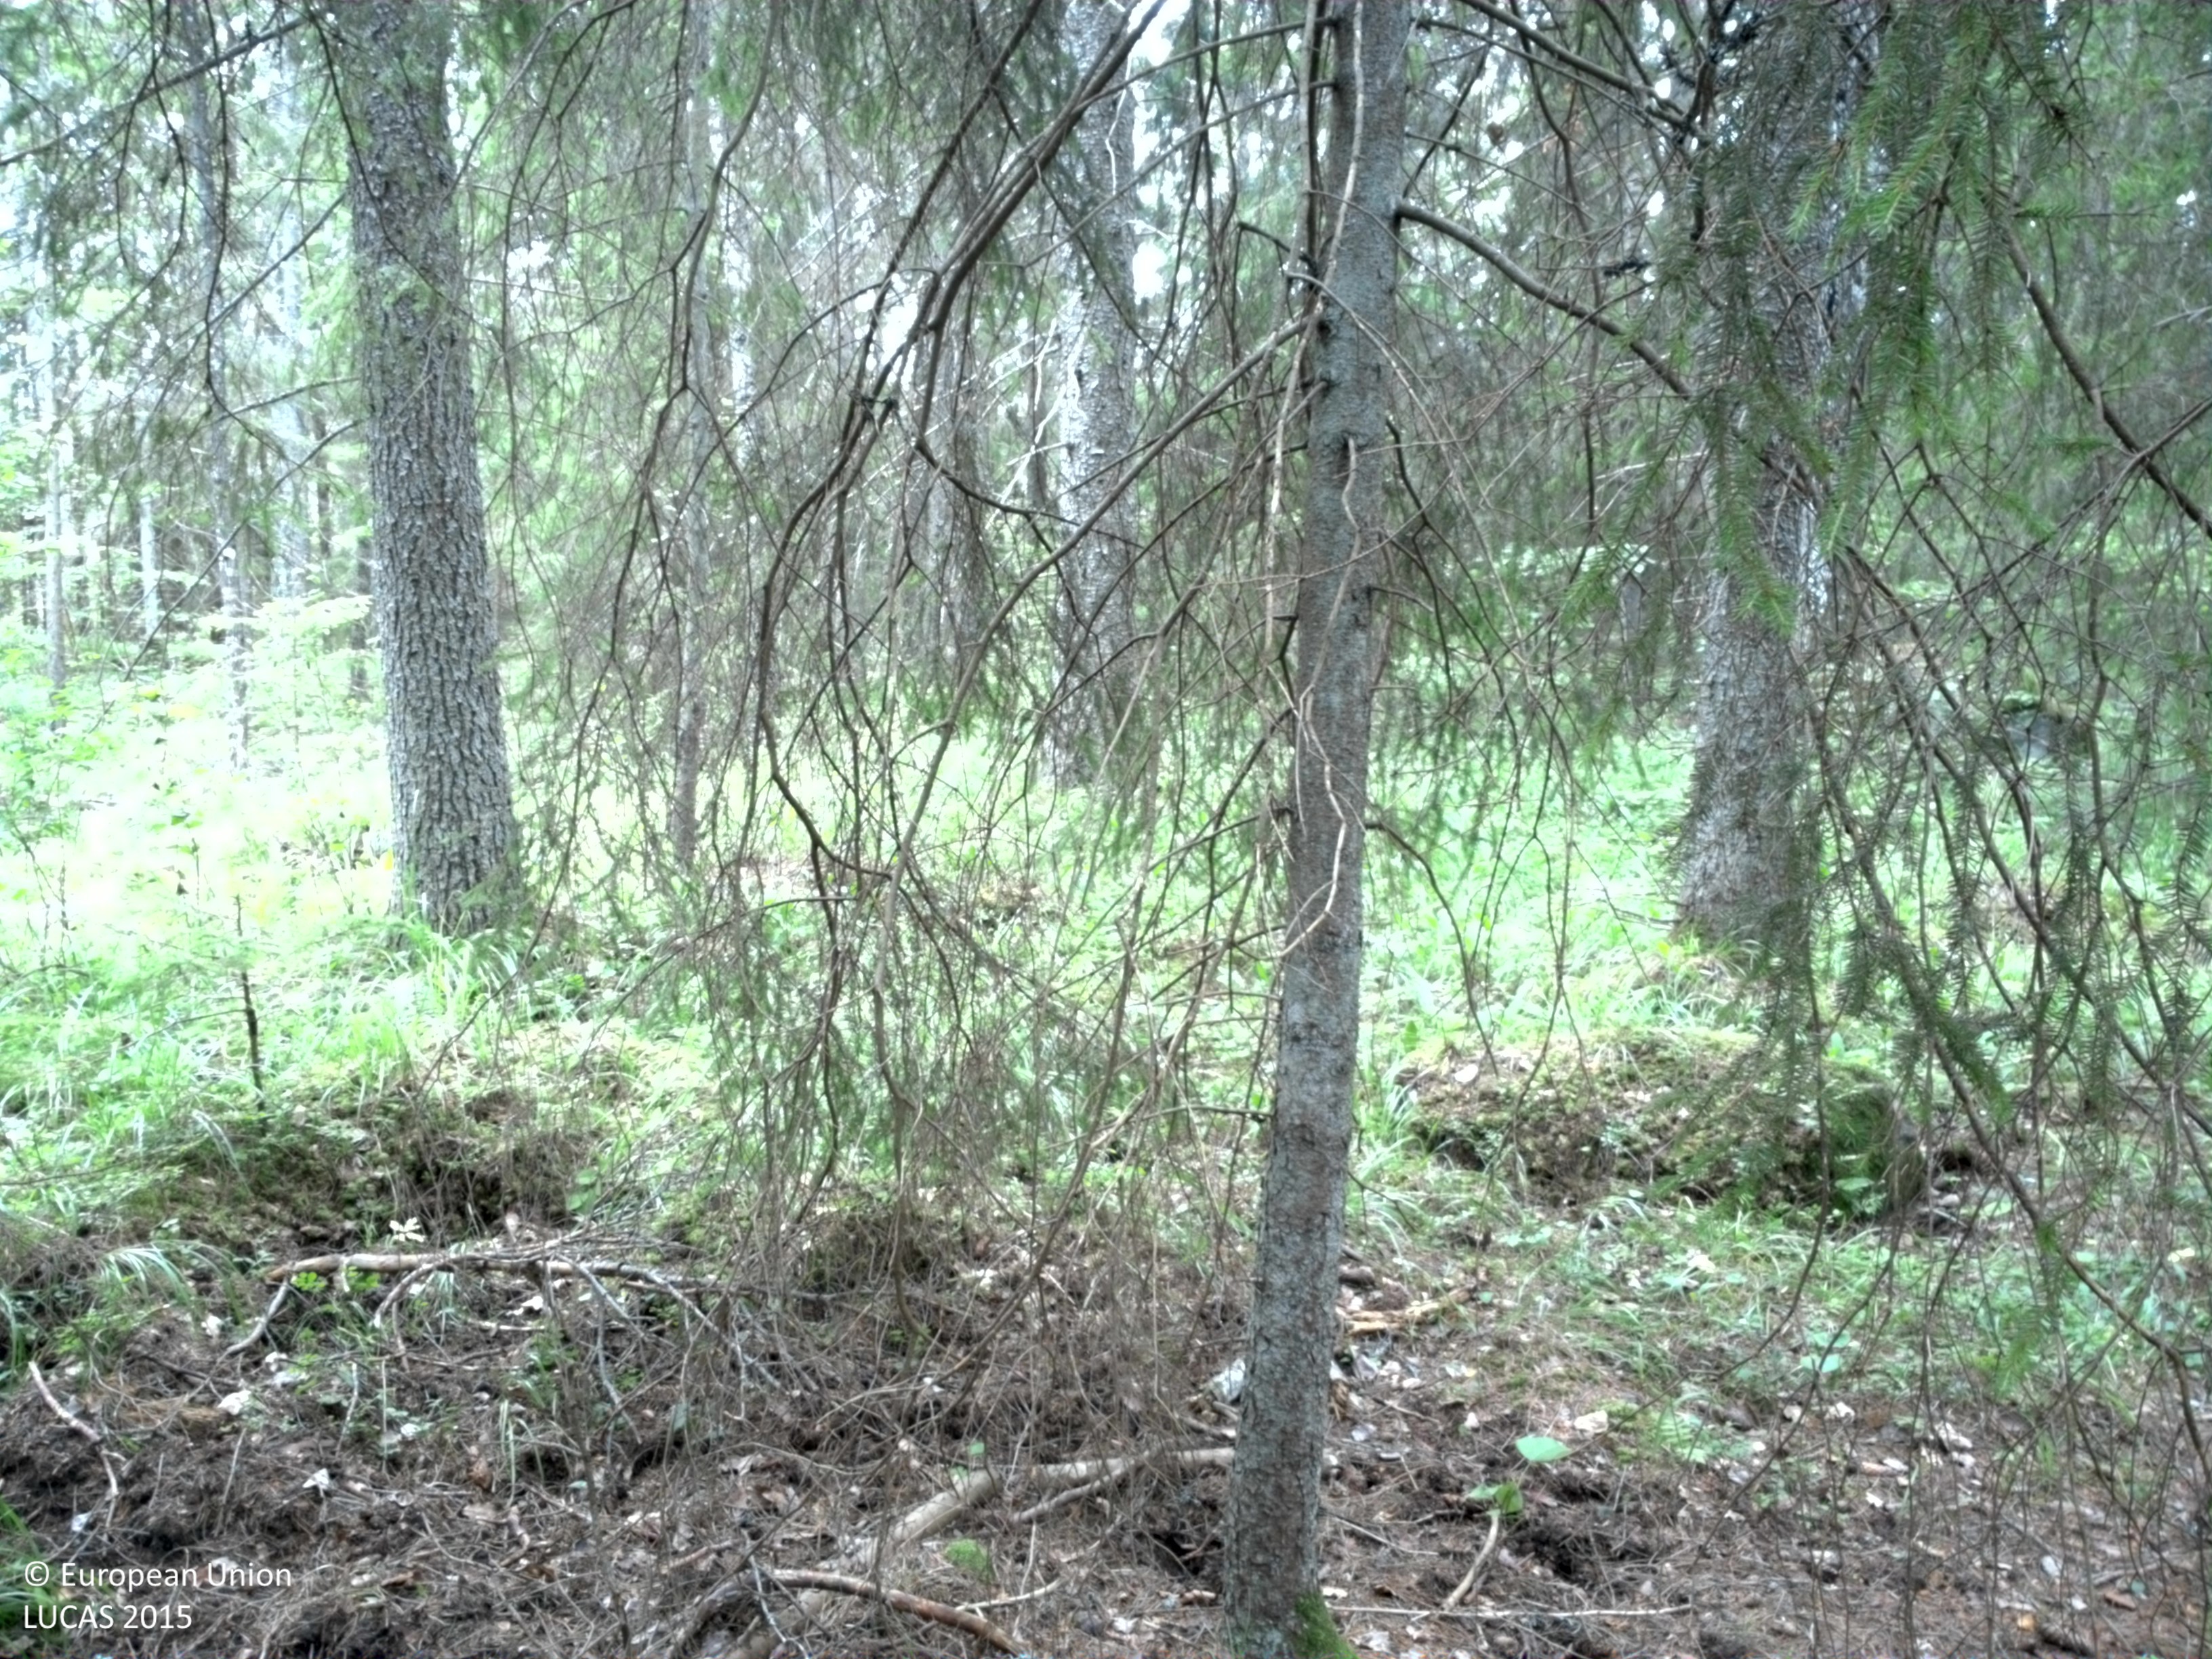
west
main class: Woodland
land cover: Spruce dominated coniferous woodland
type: boreal forest
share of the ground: > 75 %
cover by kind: coniferous forest trees 65 %, broadleaved forest trees 10 %, shrubs 10 %, herbaceous plants 10 %, lichens and mosses 5 %
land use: Forestry
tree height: > 5 m
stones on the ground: < 10 %
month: July
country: SE
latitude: 59.8328
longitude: 18.5083
